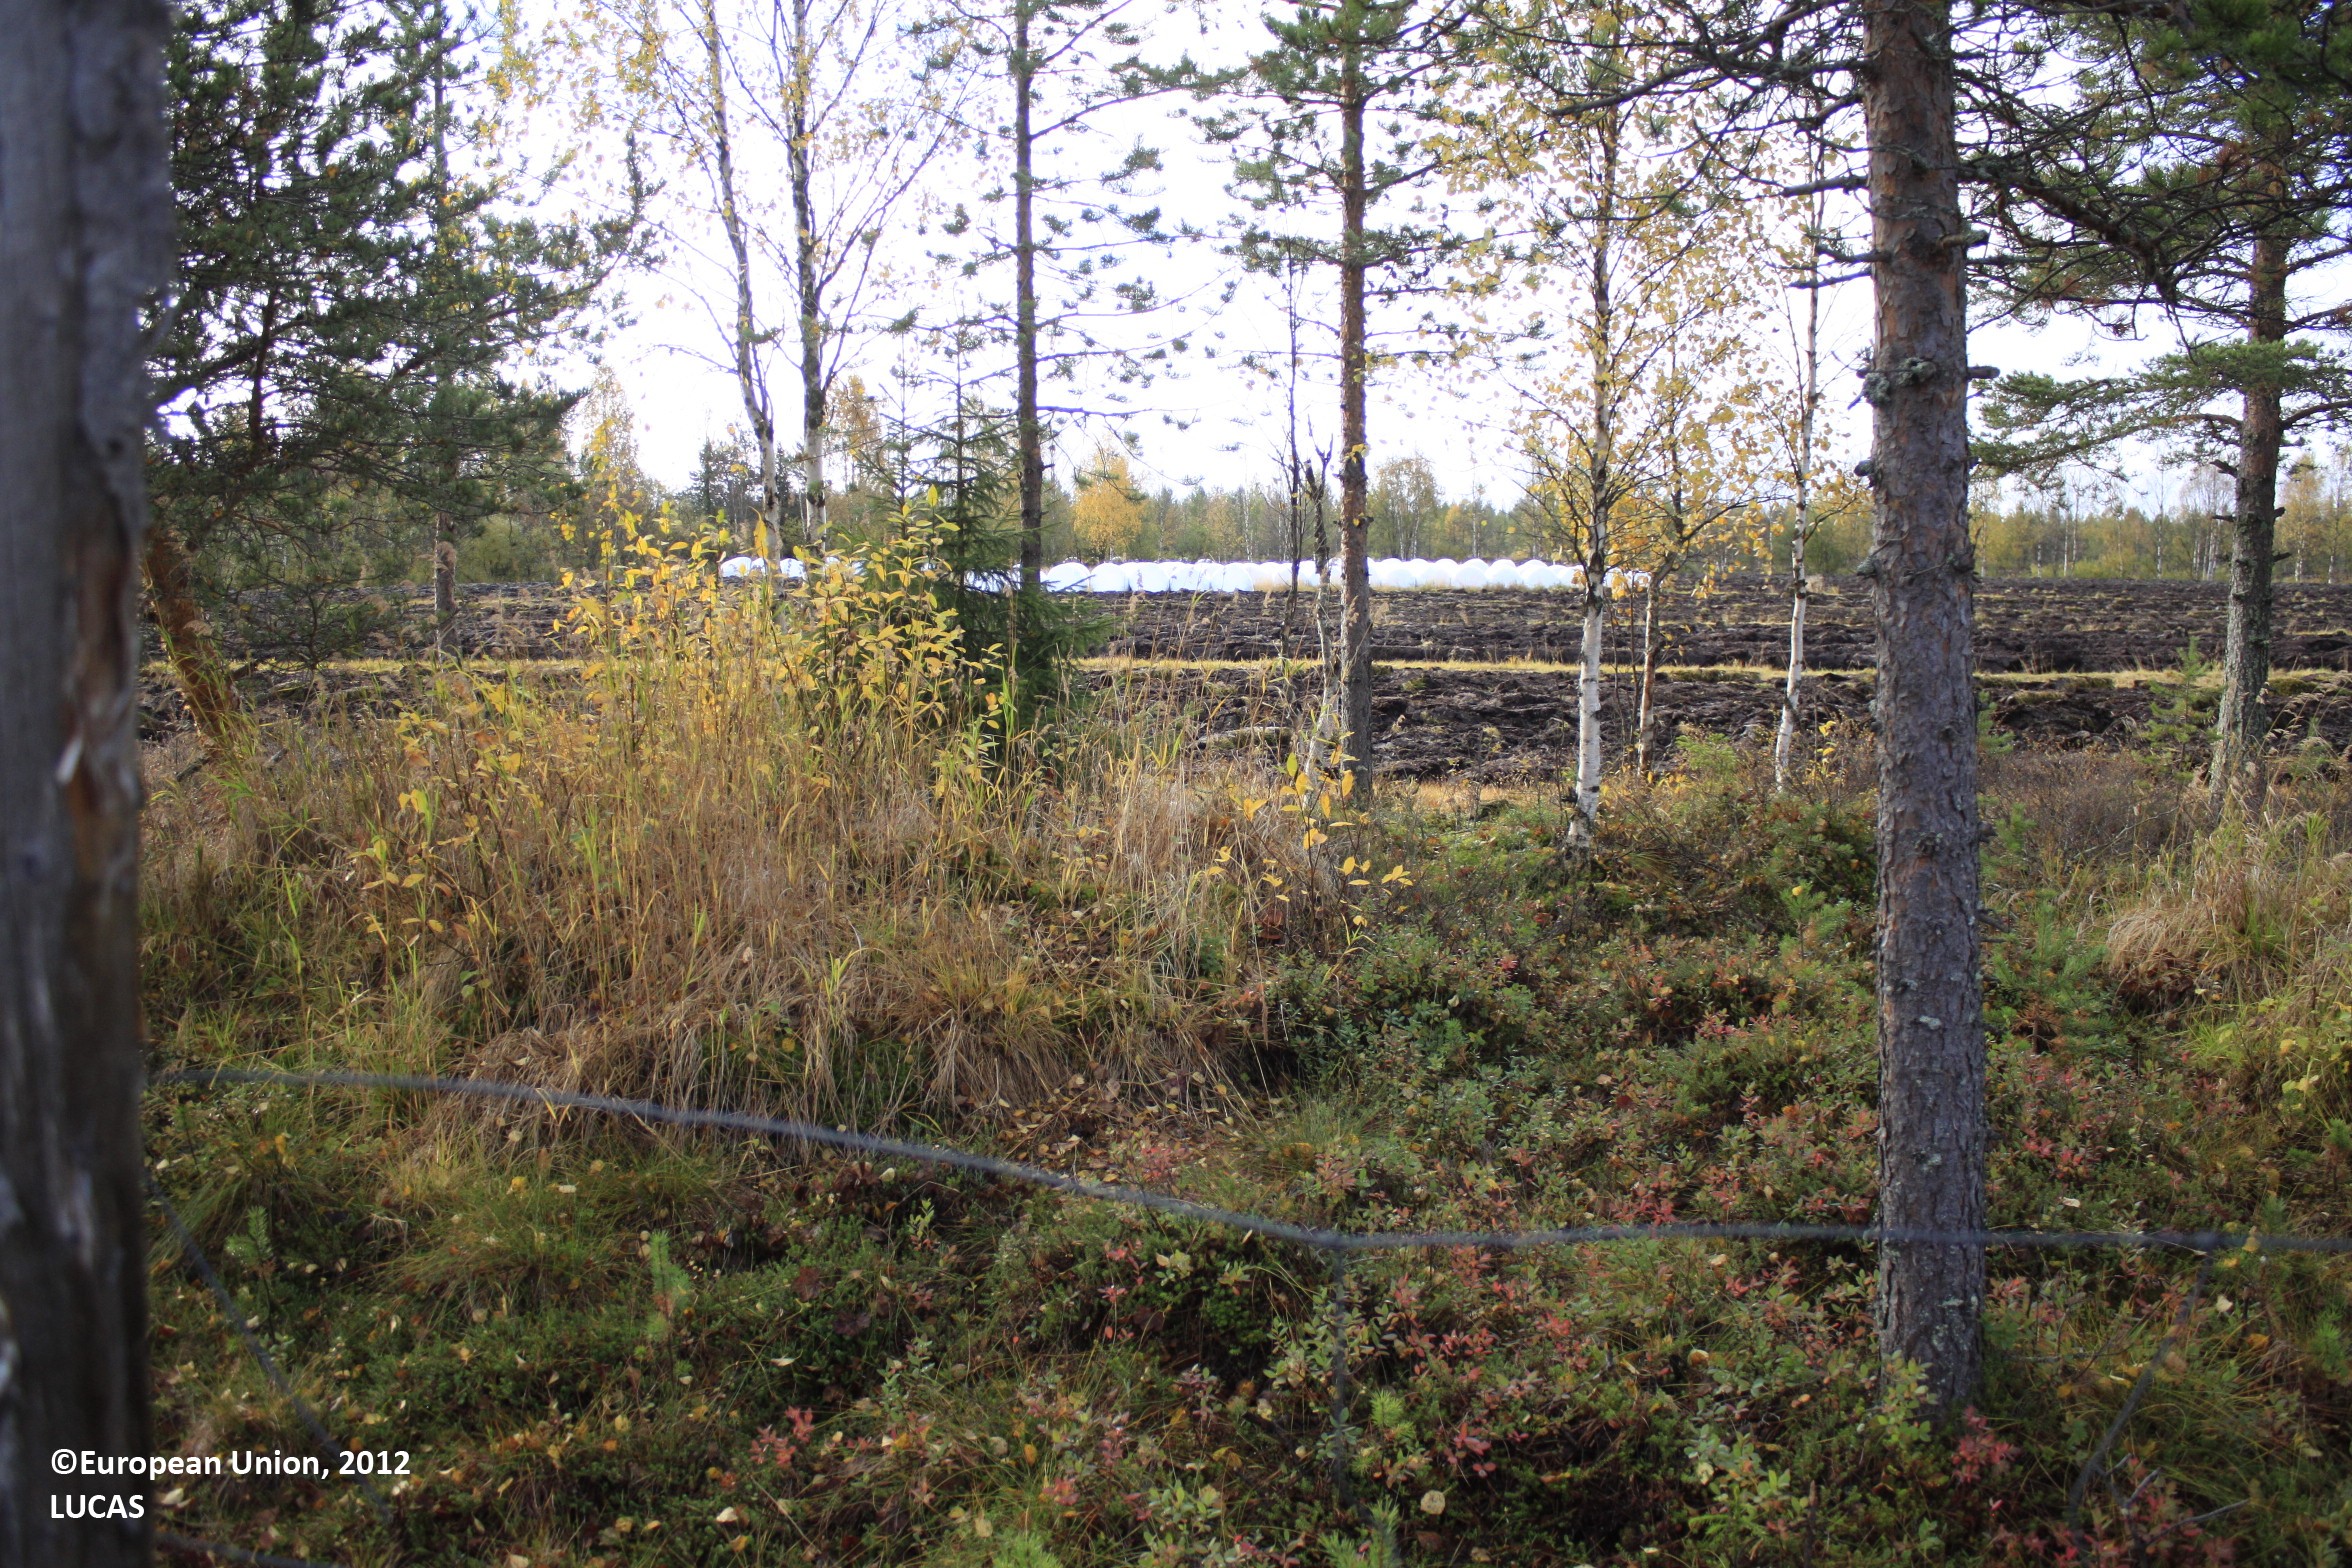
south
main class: Grassland
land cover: Grassland without tree/shrub cover
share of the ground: 25 - 50 %
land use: Agriculture (excluding fallow land and kitchen gardens)
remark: Tilled/Sowed
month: September
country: FI
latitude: 66.0336
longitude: 26.8483
